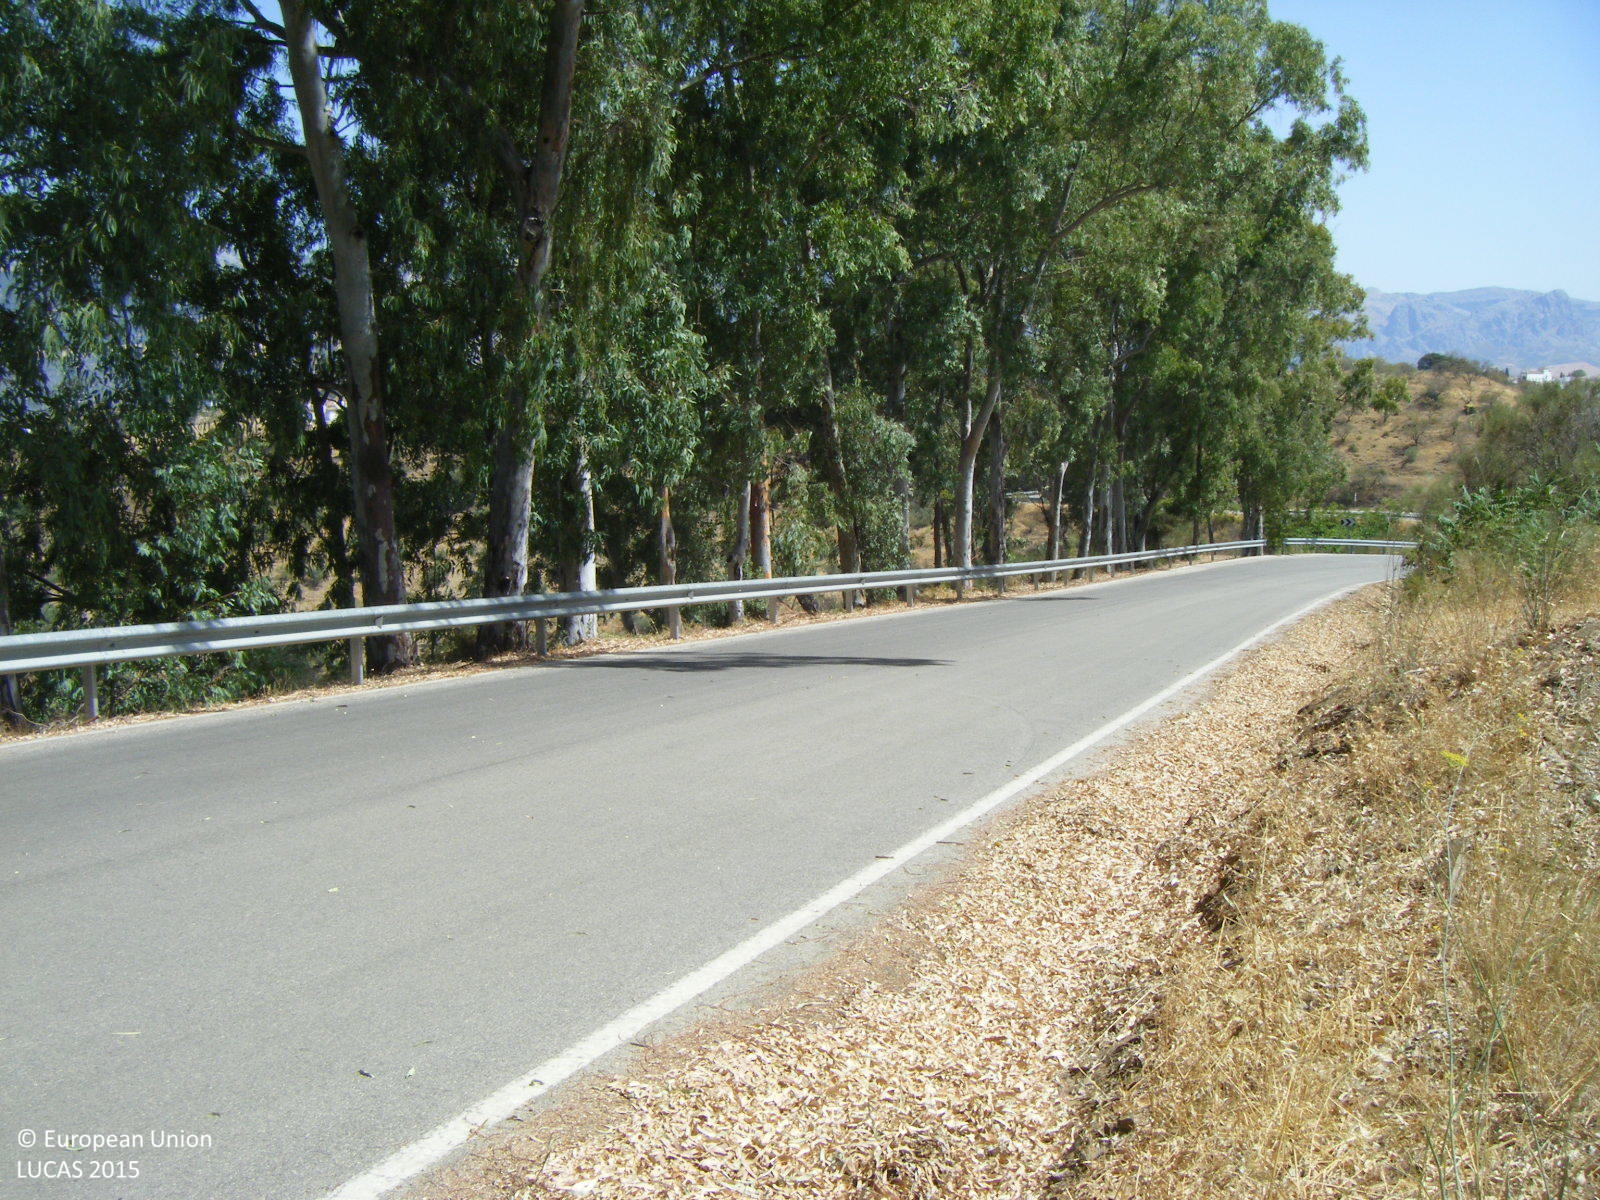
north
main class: Grassland
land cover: Grassland without tree/shrub cover
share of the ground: 50 - 75 %
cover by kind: herbaceous plants 70 %, unconsolidated bare surface 30 %
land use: Semi-natural and natural areas not in use
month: July
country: ES
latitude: 36.8930
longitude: -4.3441
